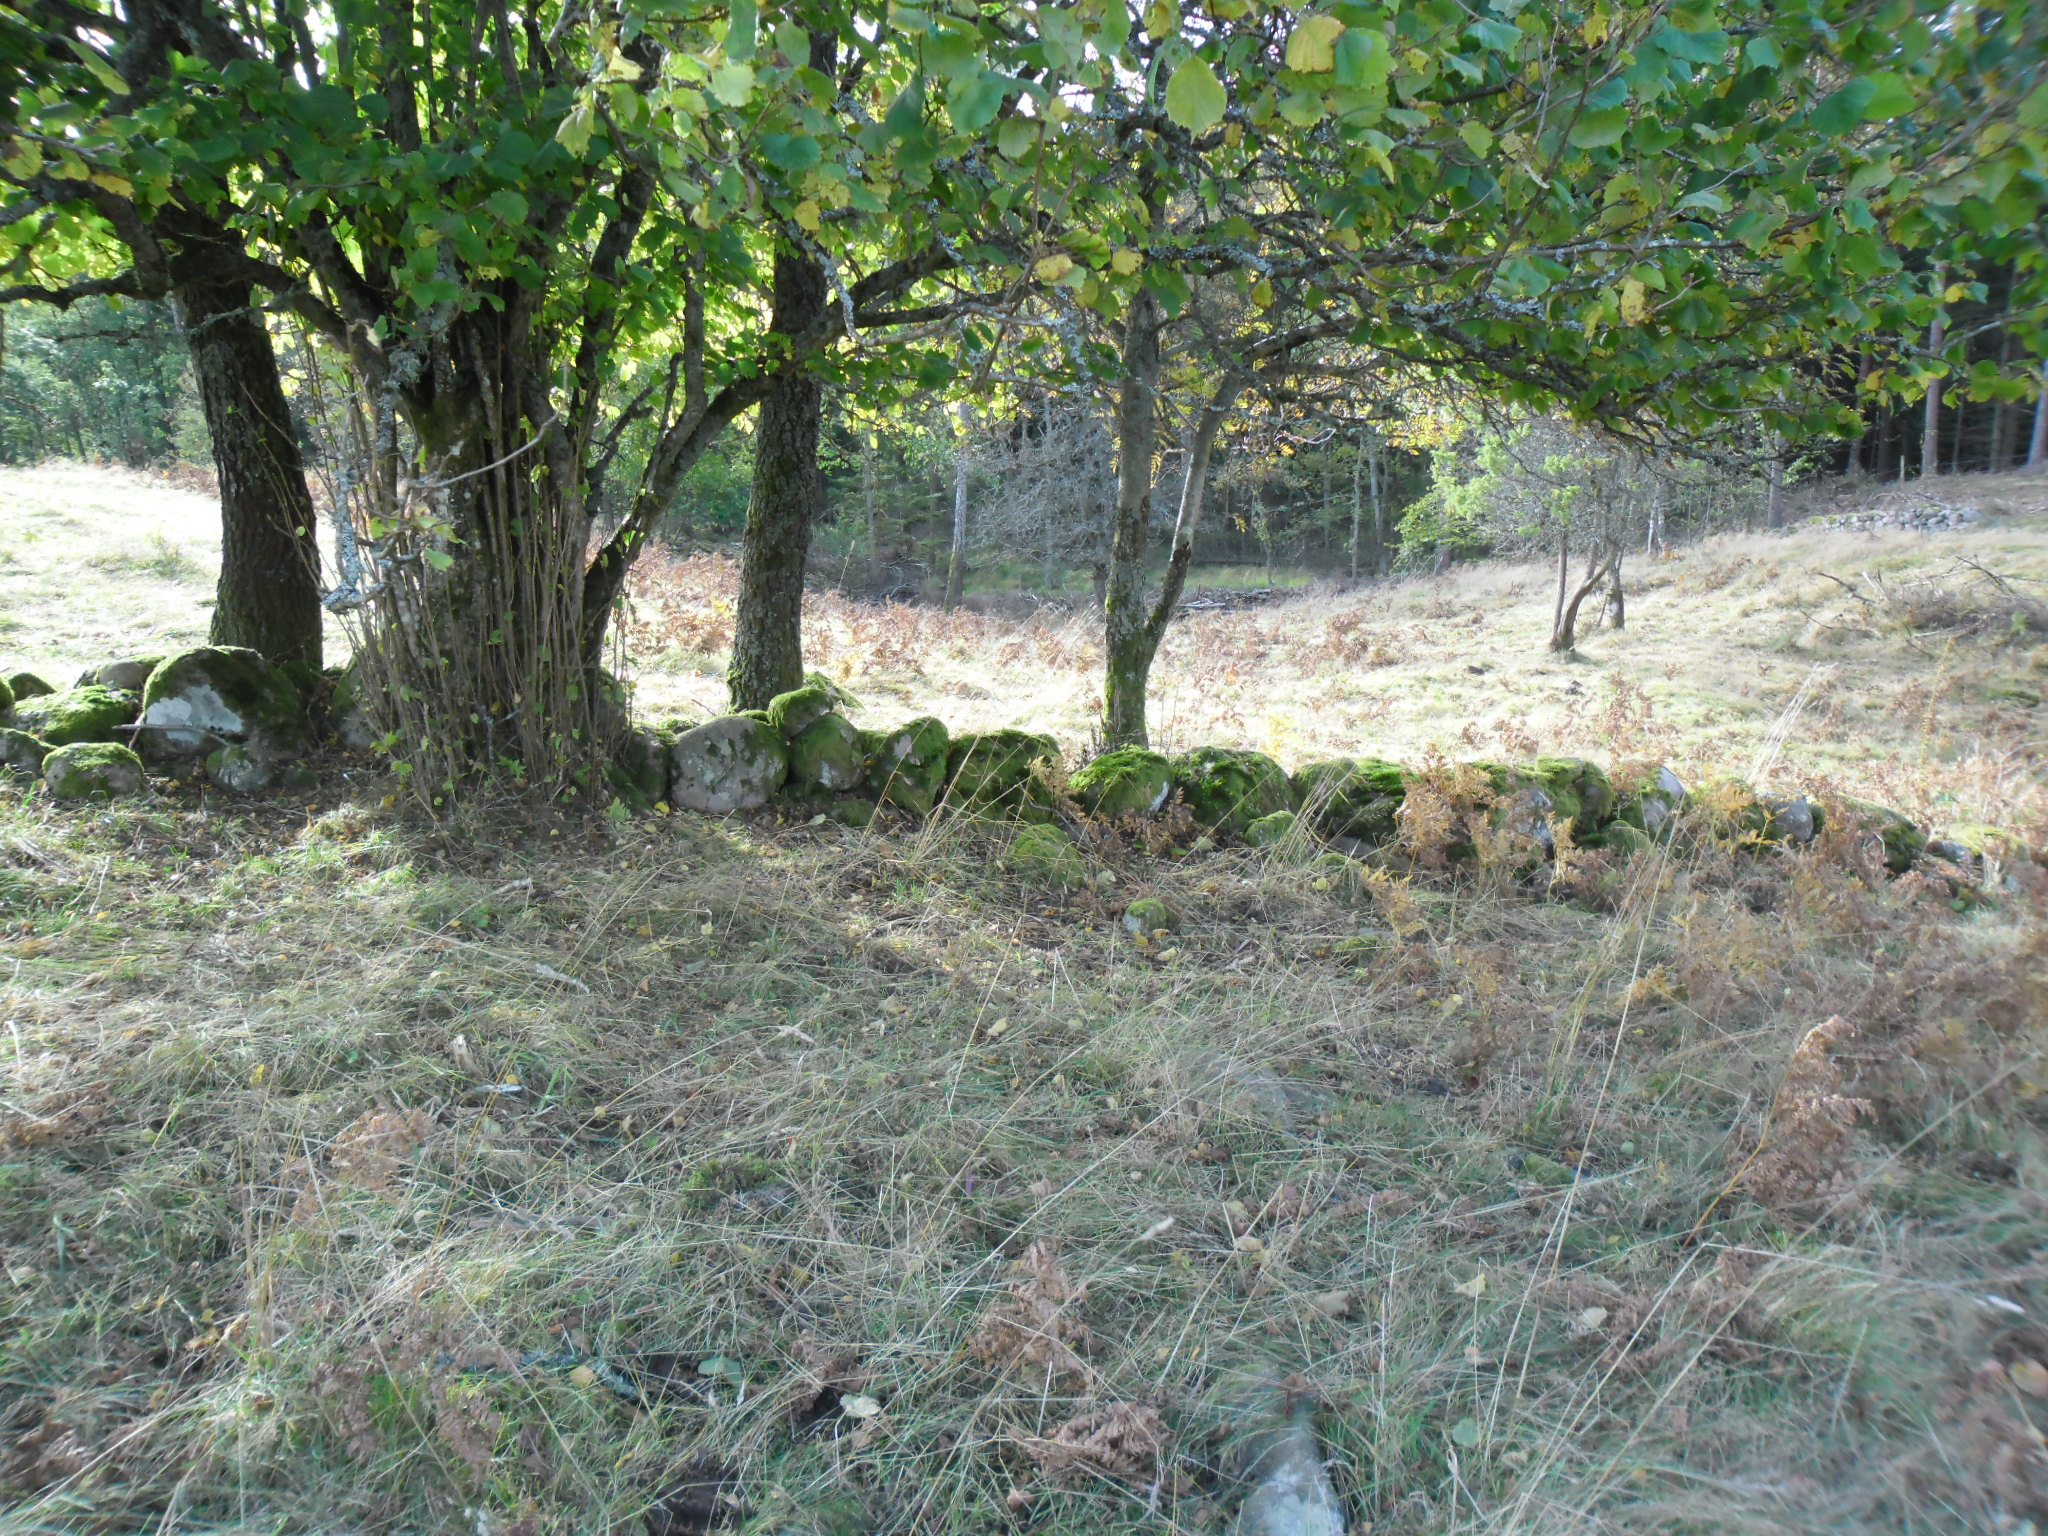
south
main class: Grassland
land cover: Grassland without tree/shrub cover
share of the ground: > 75 %
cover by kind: herbaceous plants 100 %
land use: Agriculture (excluding fallow land and kitchen gardens)
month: October
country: SE
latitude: 56.6897
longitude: 13.1152
